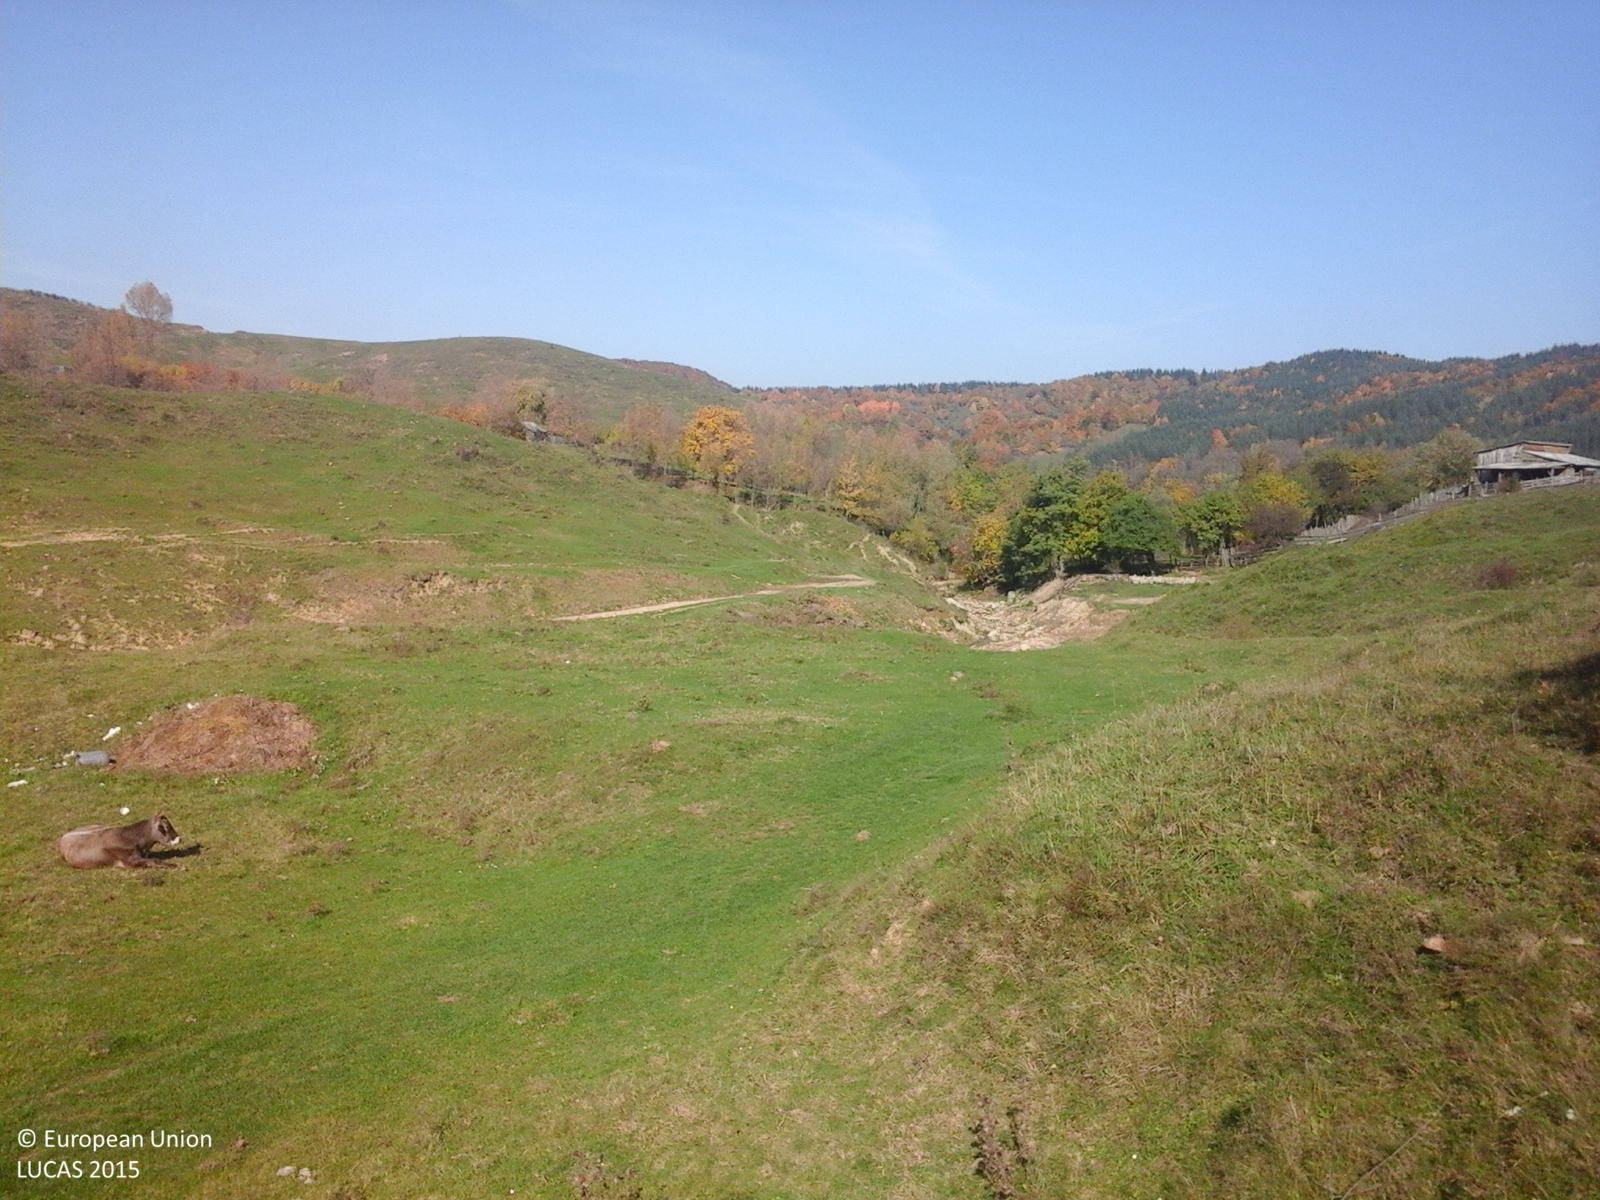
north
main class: Grassland
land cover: Grassland without tree/shrub cover
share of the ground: > 75 %
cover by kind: herbaceous plants 100 %
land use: Agriculture (excluding fallow land and kitchen gardens)
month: October
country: RO
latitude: 46.0311
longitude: 26.7384
